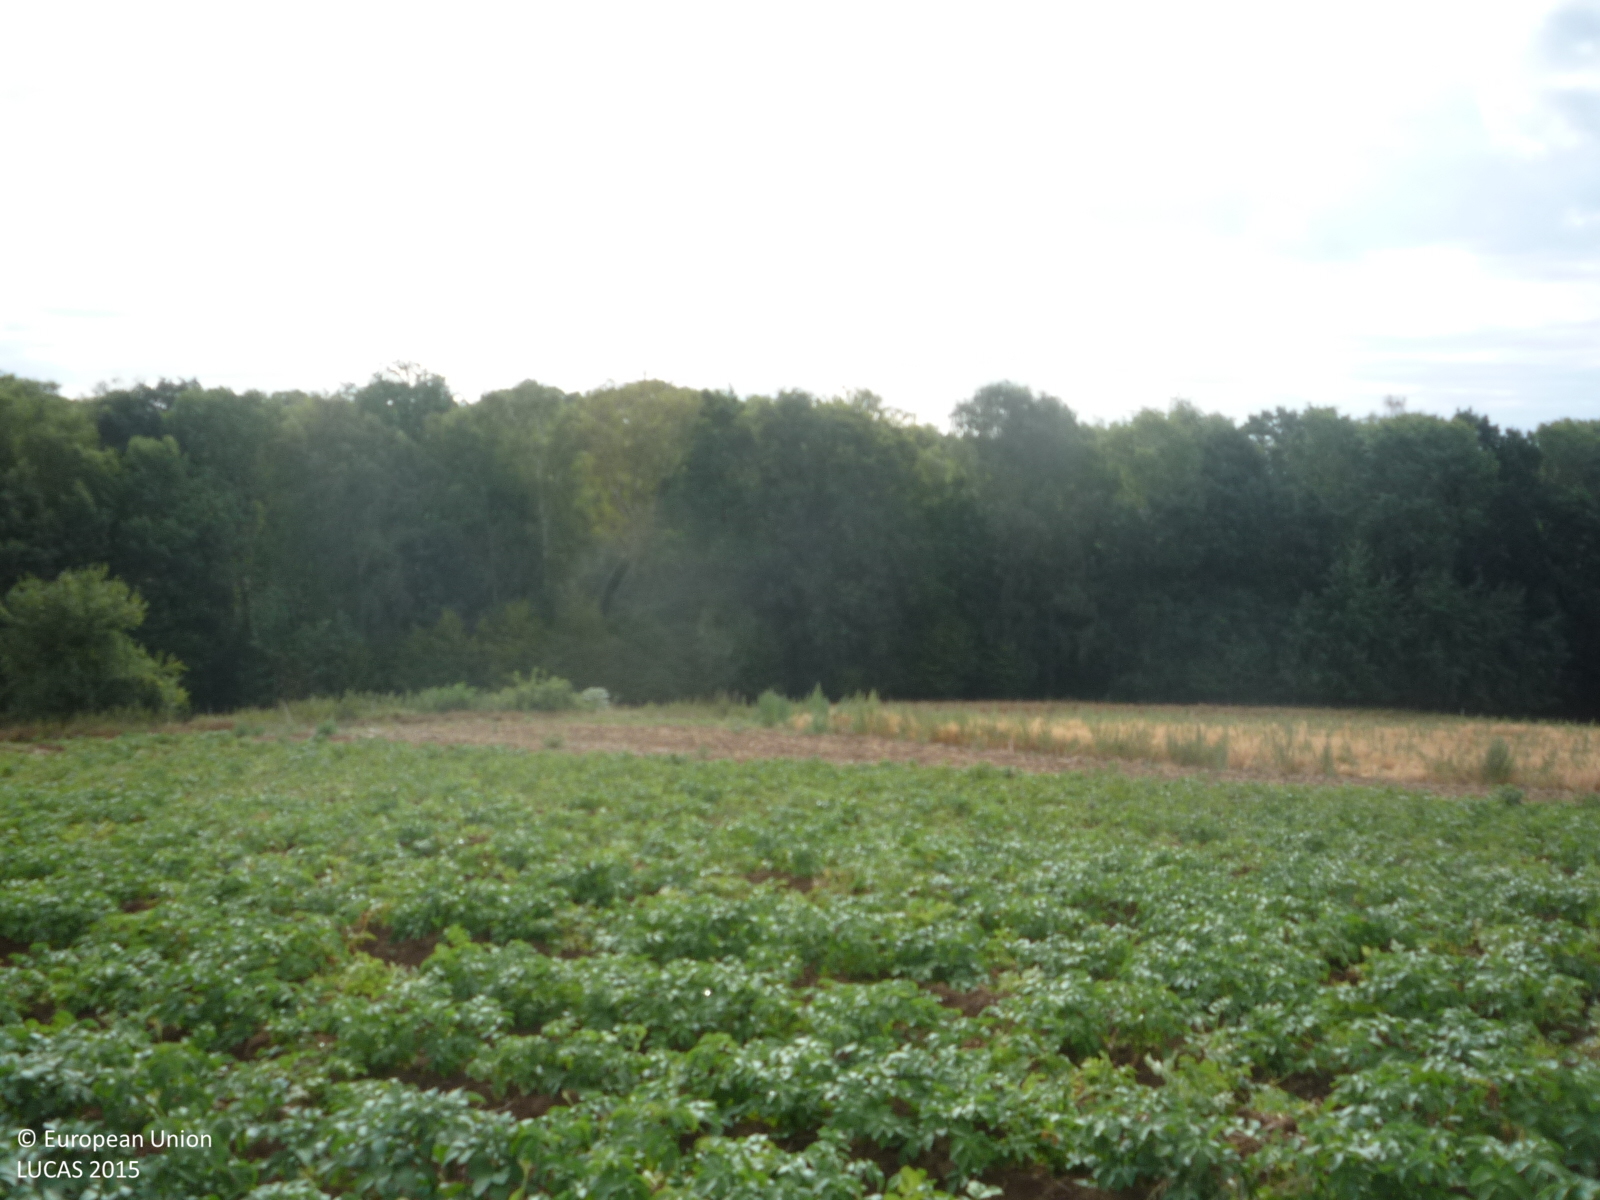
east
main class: Cropland
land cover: Potatoes
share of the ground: > 75 %
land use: Agriculture (excluding fallow land and kitchen gardens)
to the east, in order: Potatoes; Other fresh vegetables; Grassland with sparse tree/shrub cover; Other leguminous and mixtures for fodder; Broadleaved woodland; Tracks; Broadleaved woodland; Rivers and streams; Broadleaved woodland; Rape and turnip rape; Grassland with sparse tree/shrub cover; Broadleaved woodland
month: July
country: CZ
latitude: 50.4069
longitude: 15.2236
